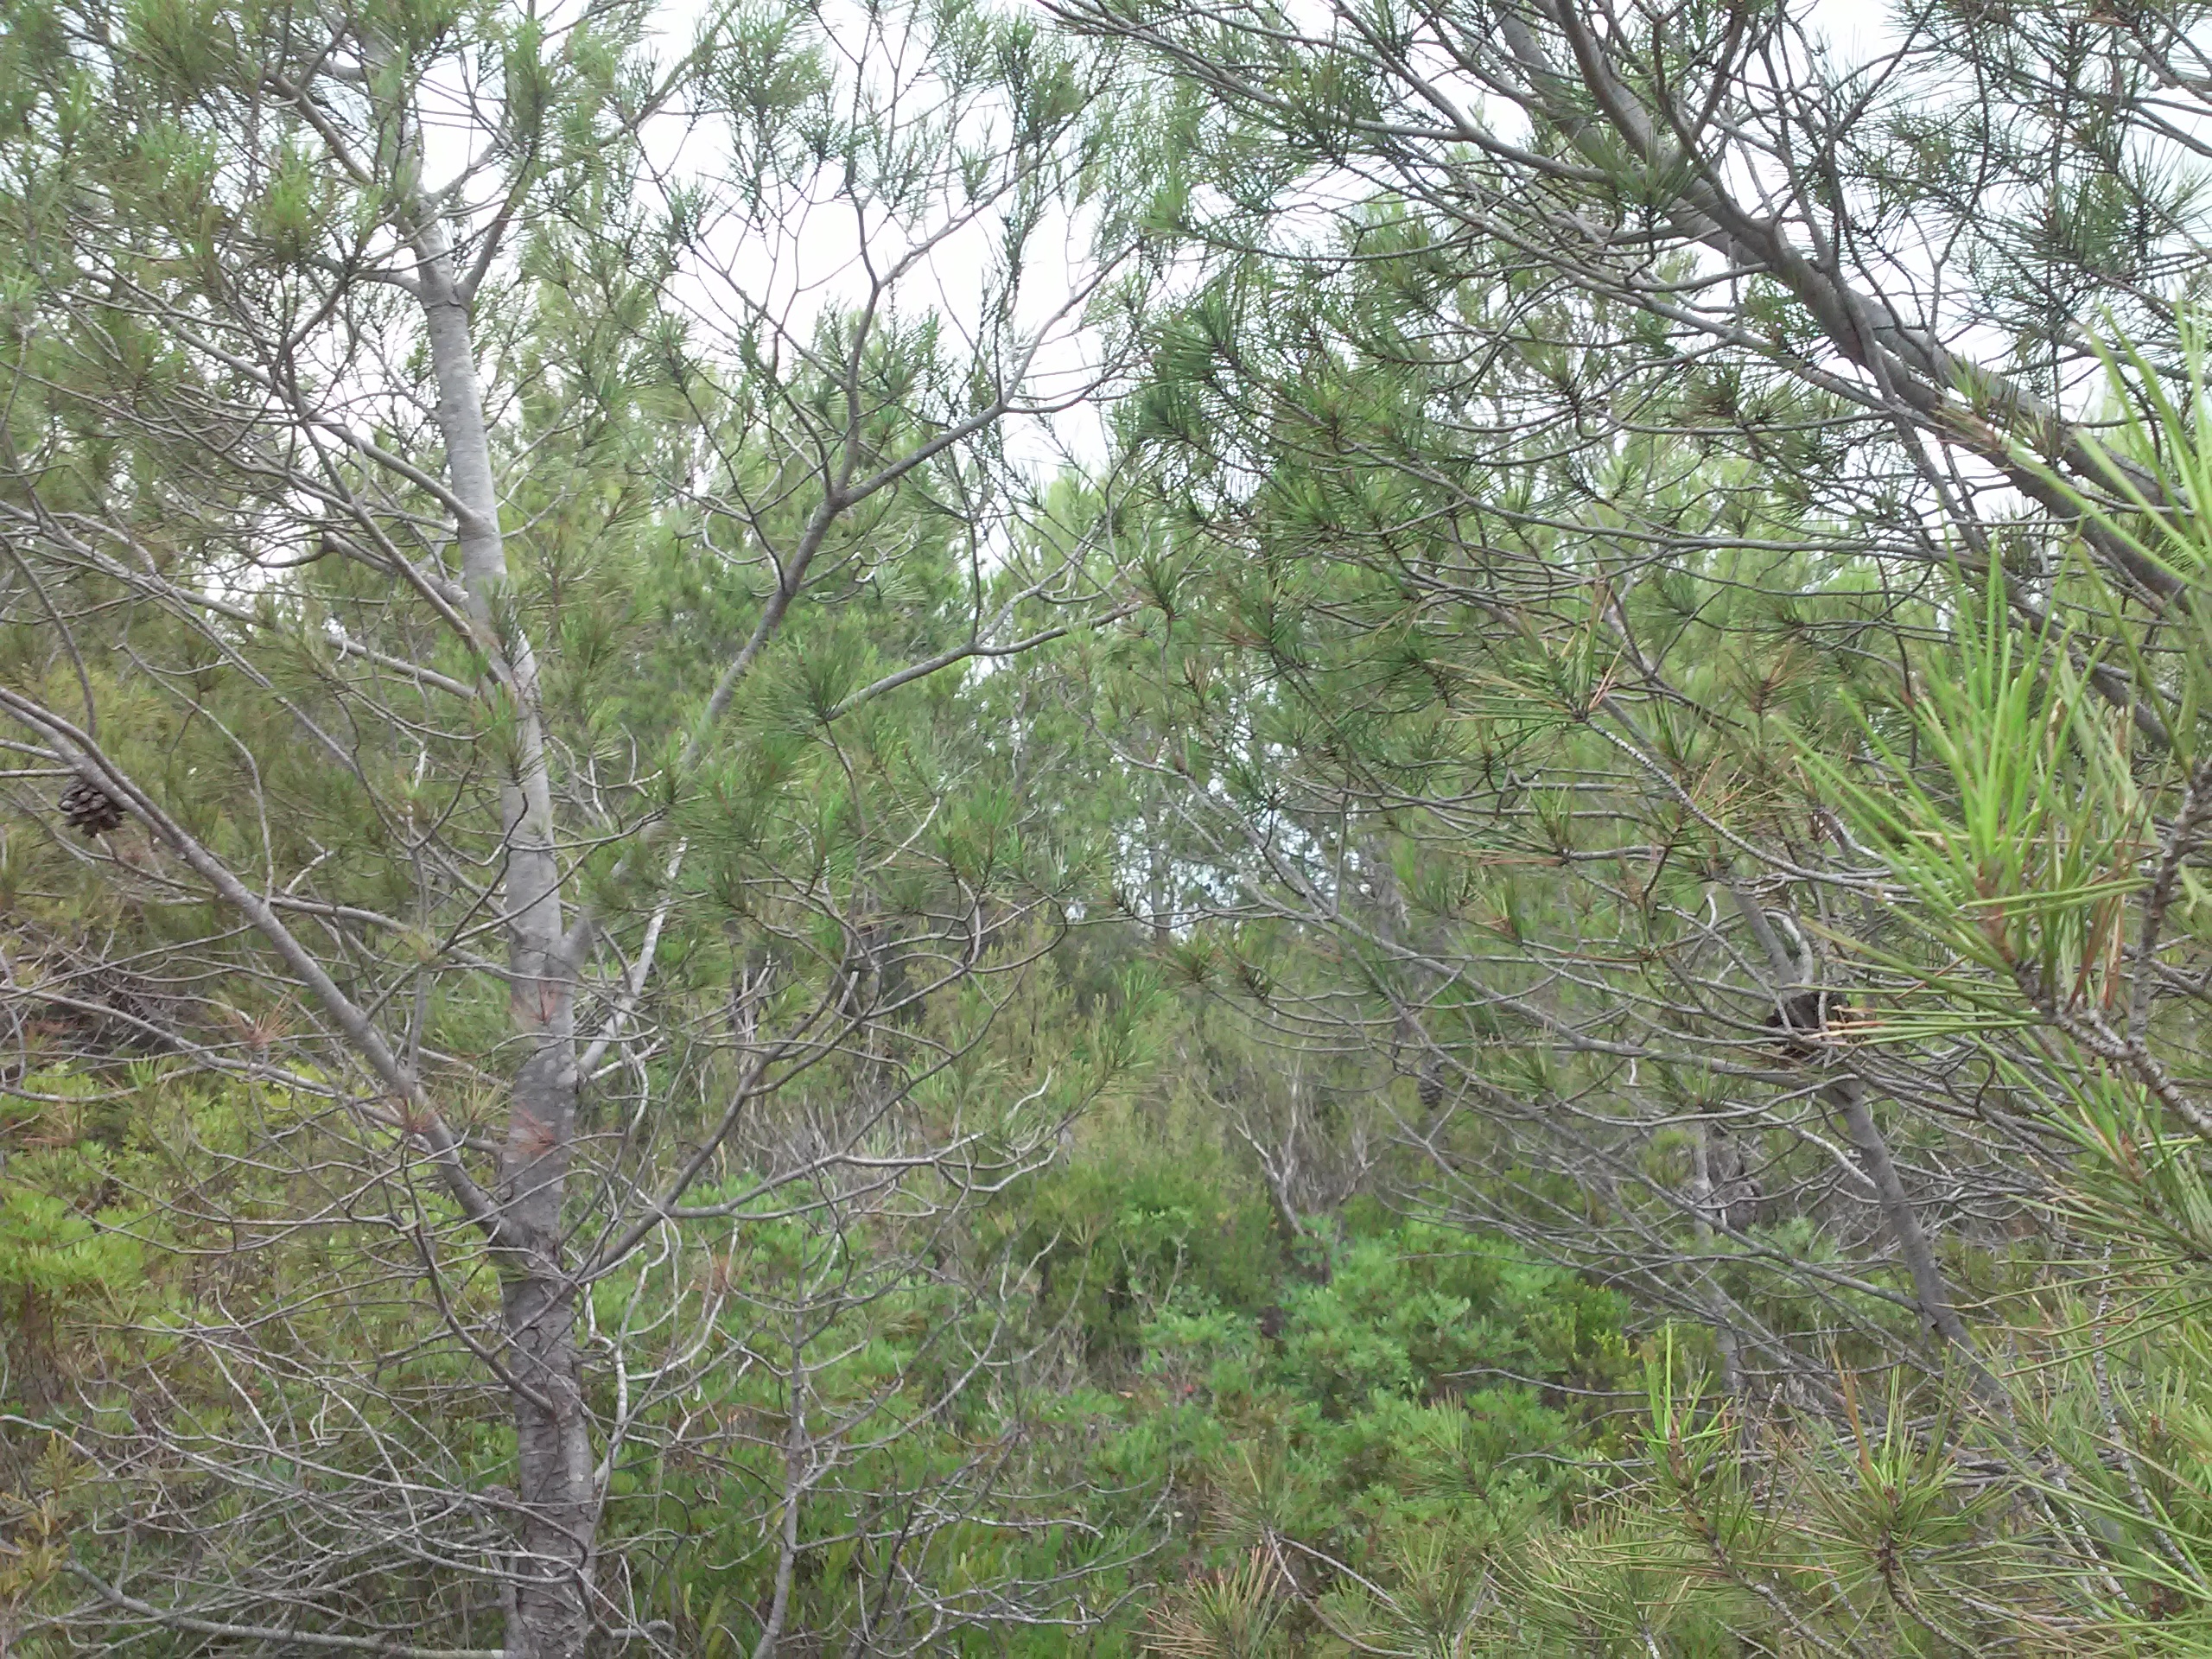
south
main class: Woodland
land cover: Pine dominated coniferous woodland
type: coniferous forest of the mediterranean region
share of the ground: 10 - 25 %
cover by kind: shrubs 50 %, coniferous forest trees 30 %, herbaceous plants 20 %
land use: Semi-natural and natural areas not in use
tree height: < 5 m
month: August
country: ES
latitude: 41.0440
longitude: 0.5104
